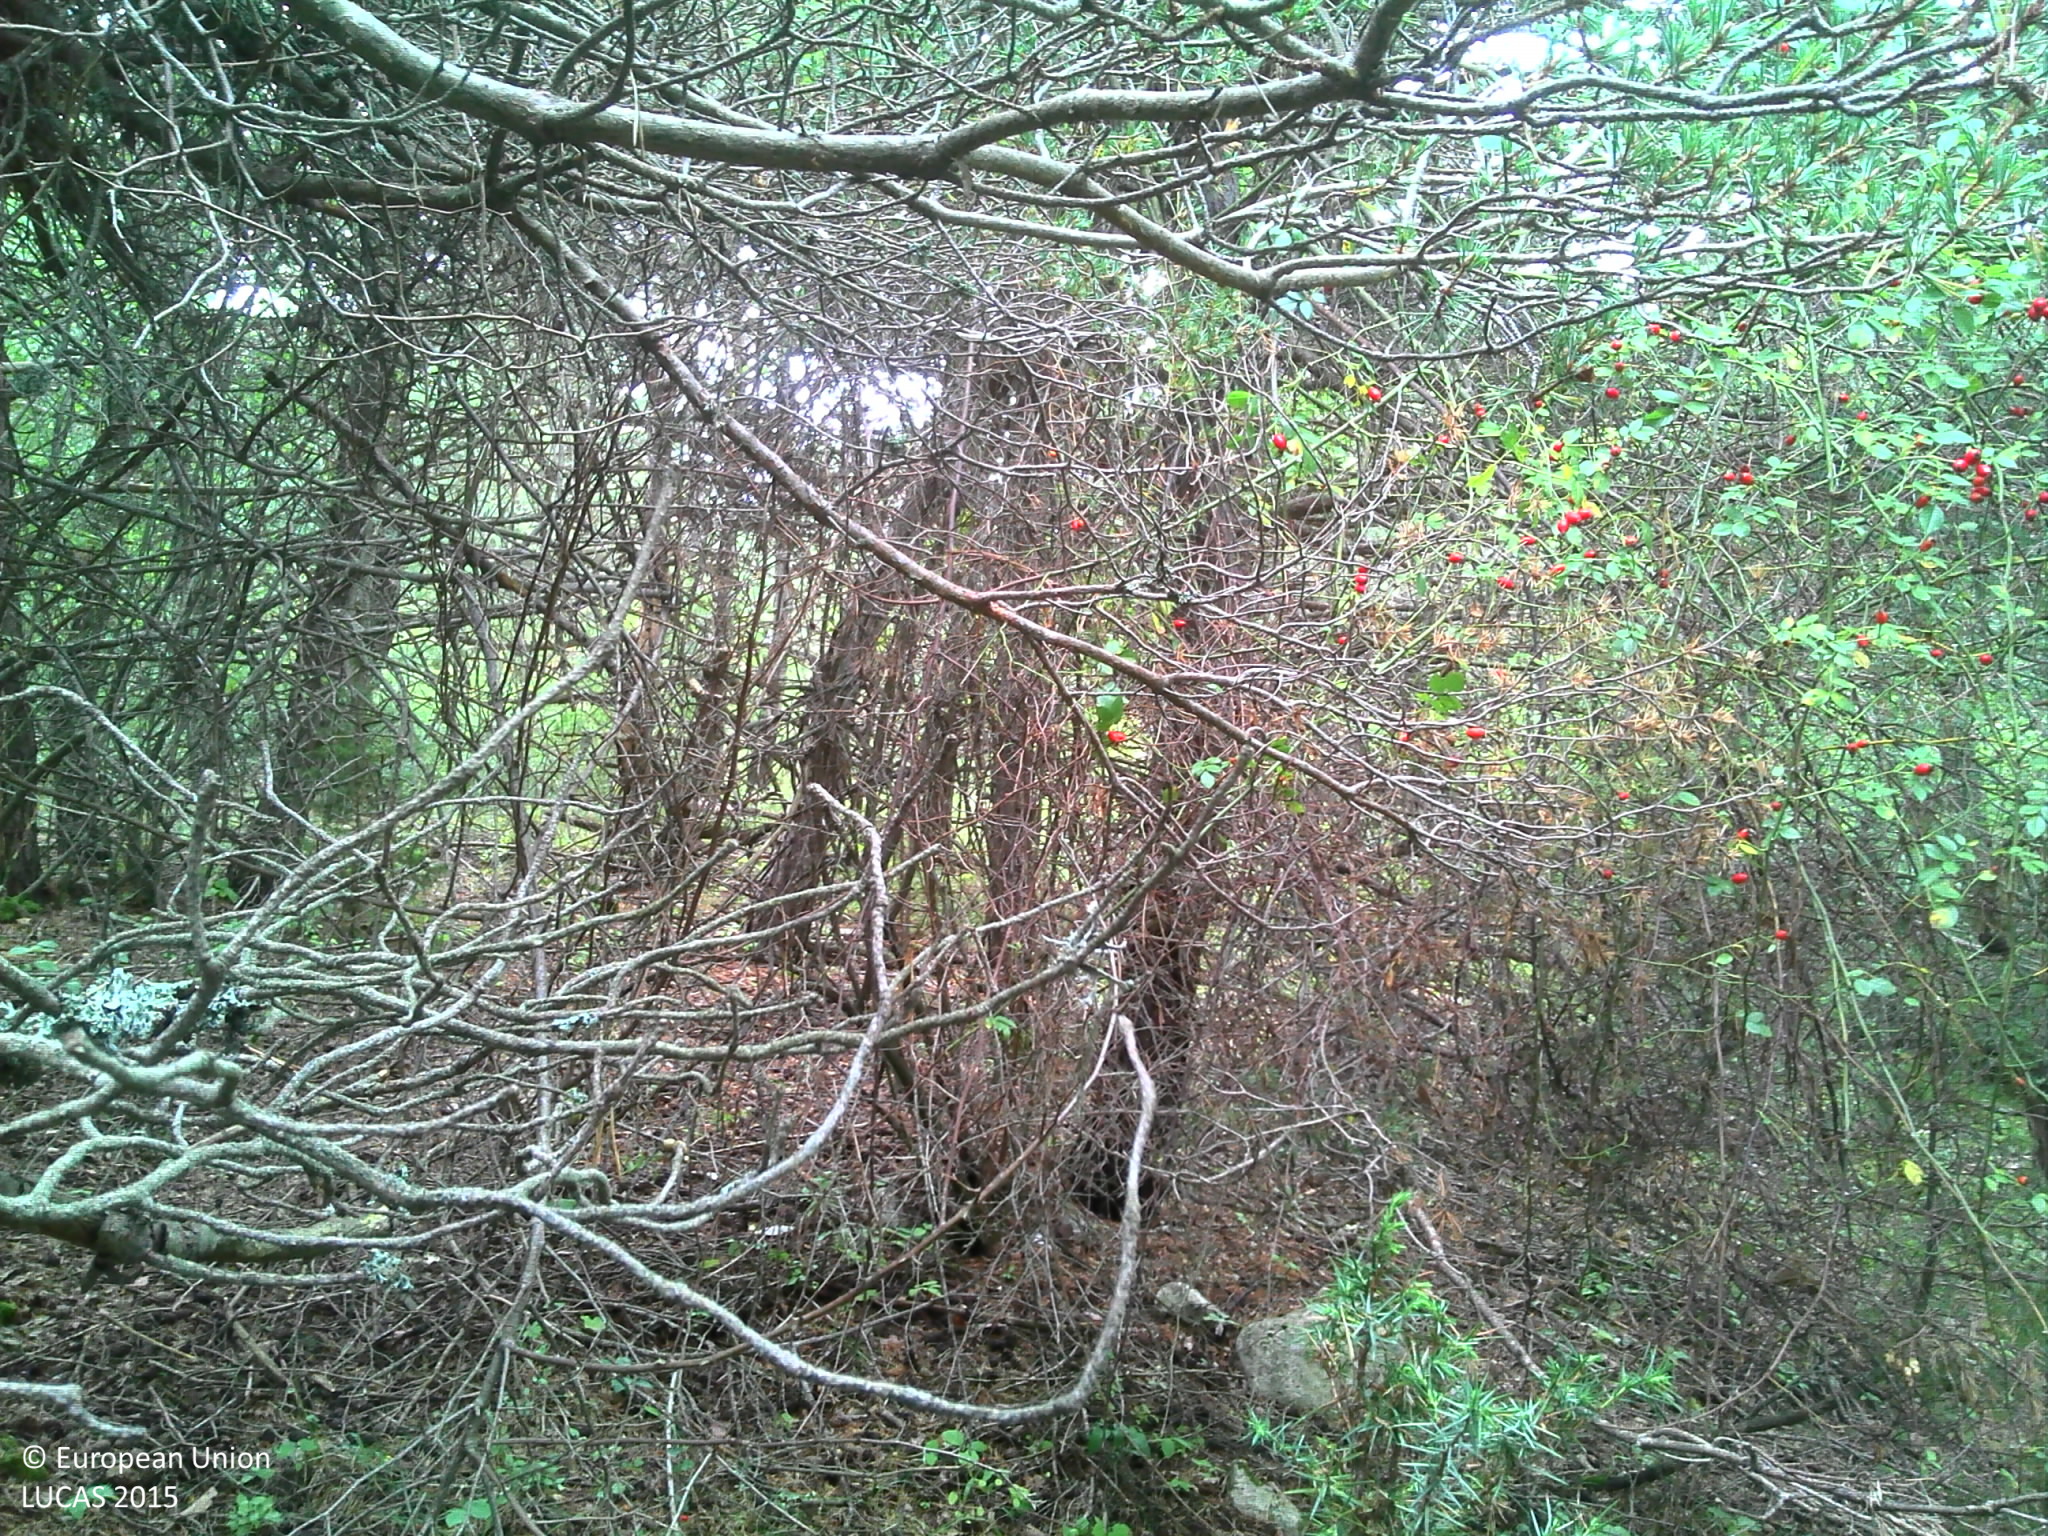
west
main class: Woodland
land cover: Pine dominated coniferous woodland
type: alpine coniferous forest
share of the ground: > 75 %
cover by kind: coniferous forest trees 90 %, broadleaved forest trees 5 %, herbaceous plants 5 %
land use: Forestry
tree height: > 5 m
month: September
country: FR
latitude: 44.5337
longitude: 5.3130
